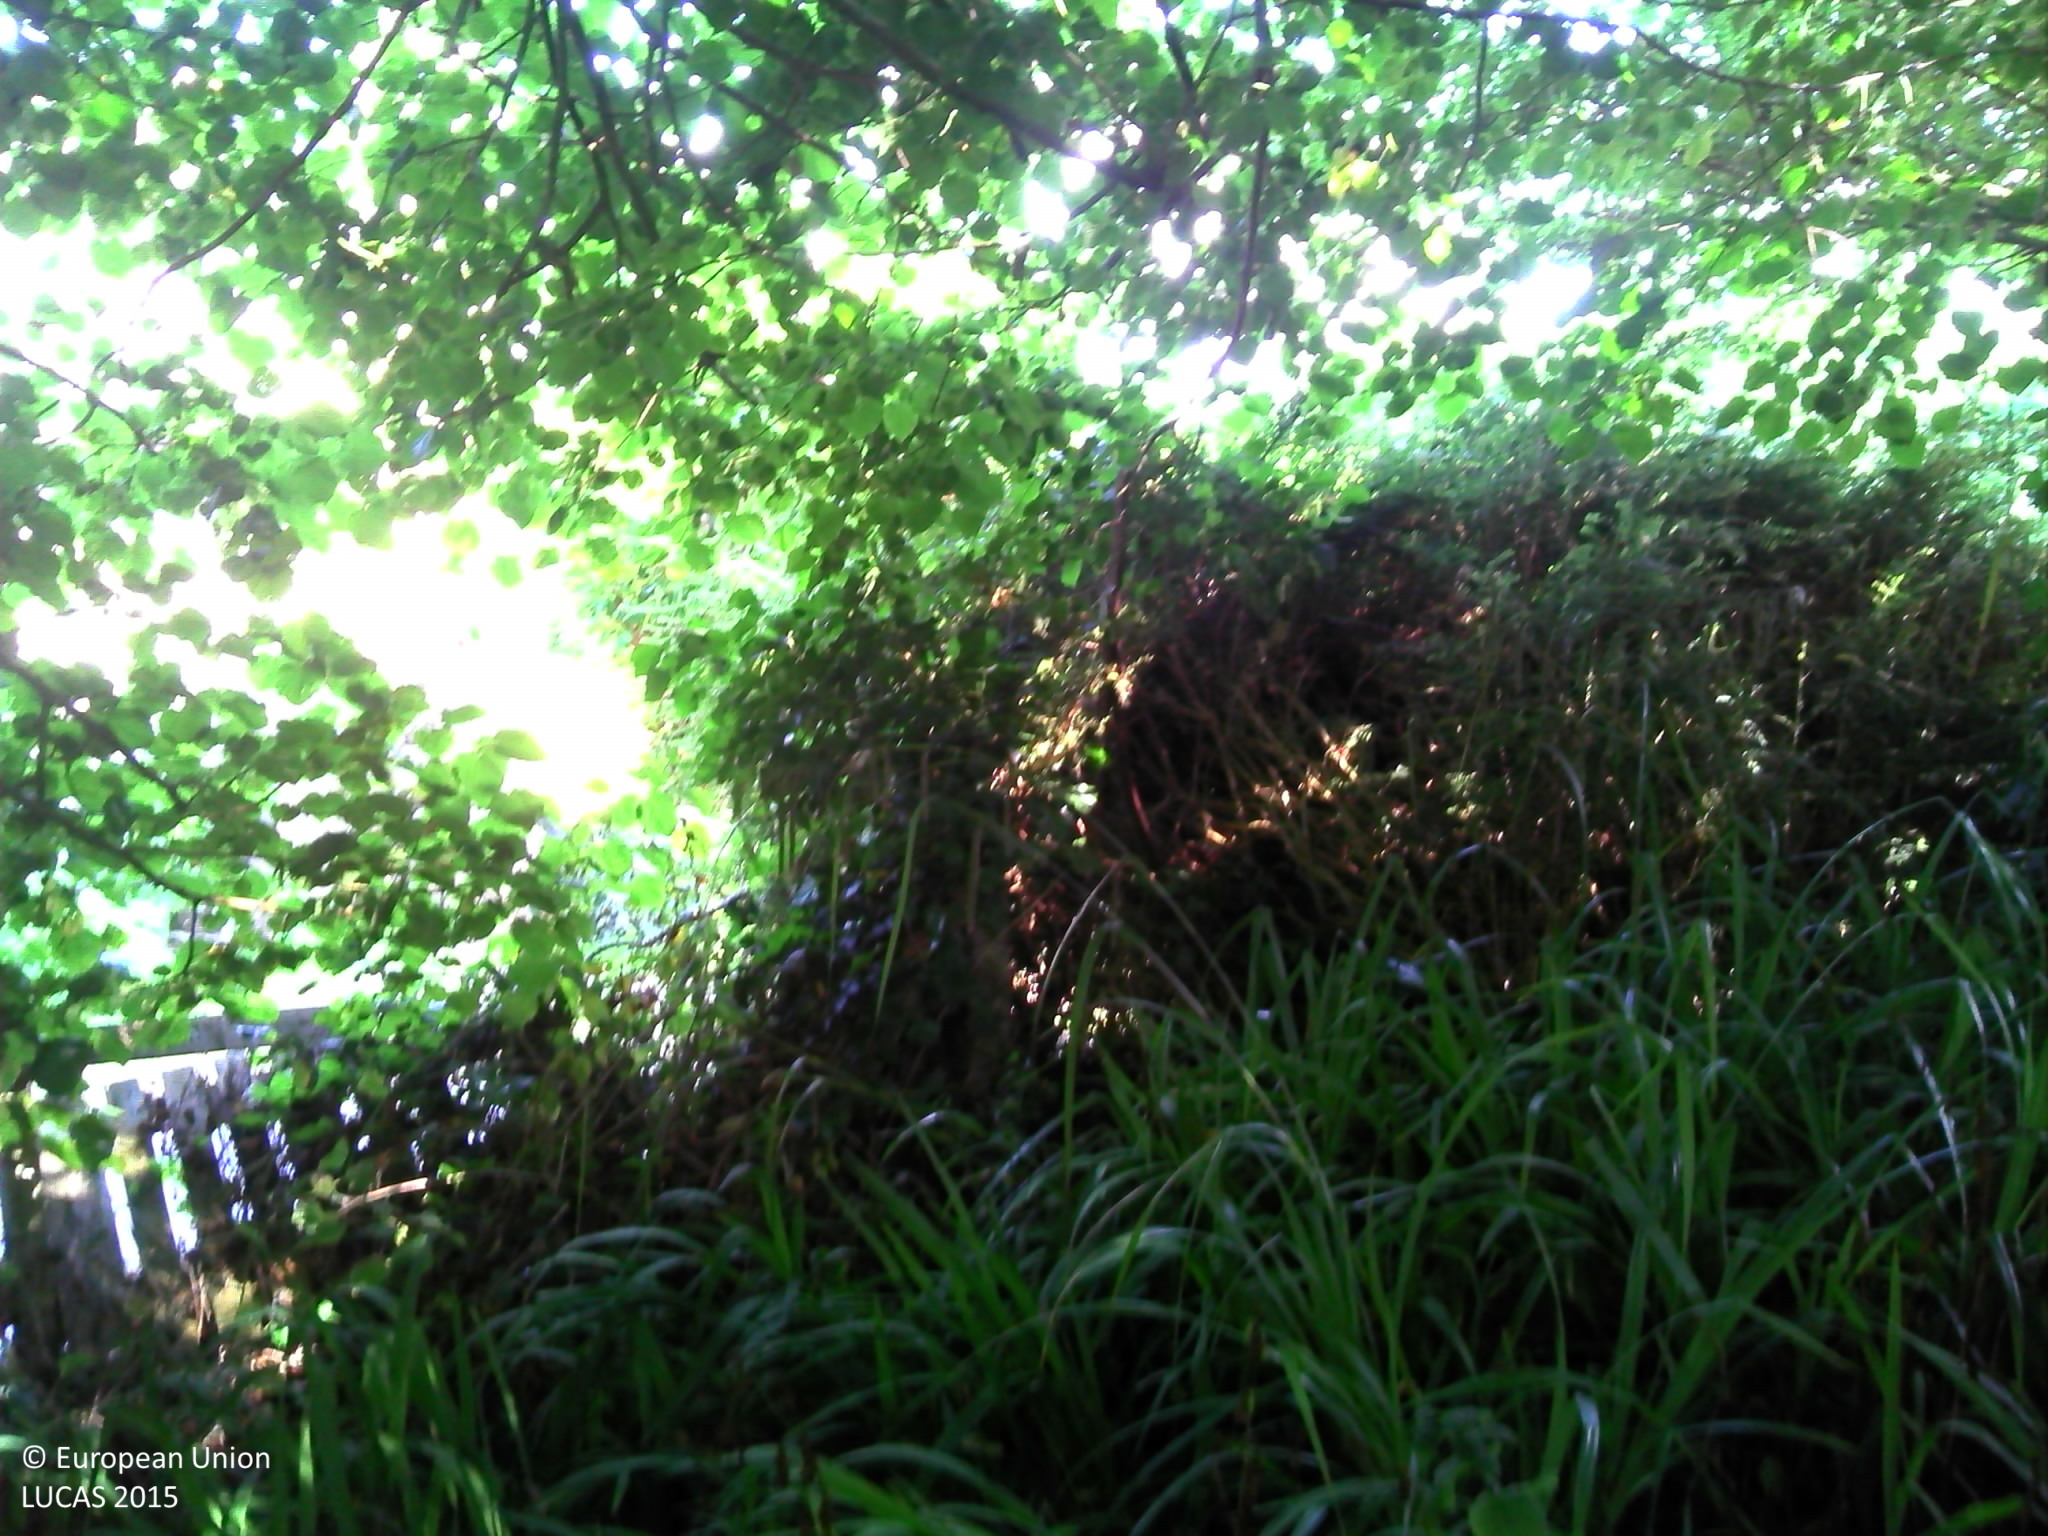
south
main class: Woodland
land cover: Broadleaved woodland
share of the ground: > 75 %
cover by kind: herbaceous plants 50 %, unconsolidated bare surface 30 %, broadleaved forest trees 15 %, coniferous forest trees 5 %
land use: Residential
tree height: > 5 m
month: July
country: FR
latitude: 48.7976
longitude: -3.4616
